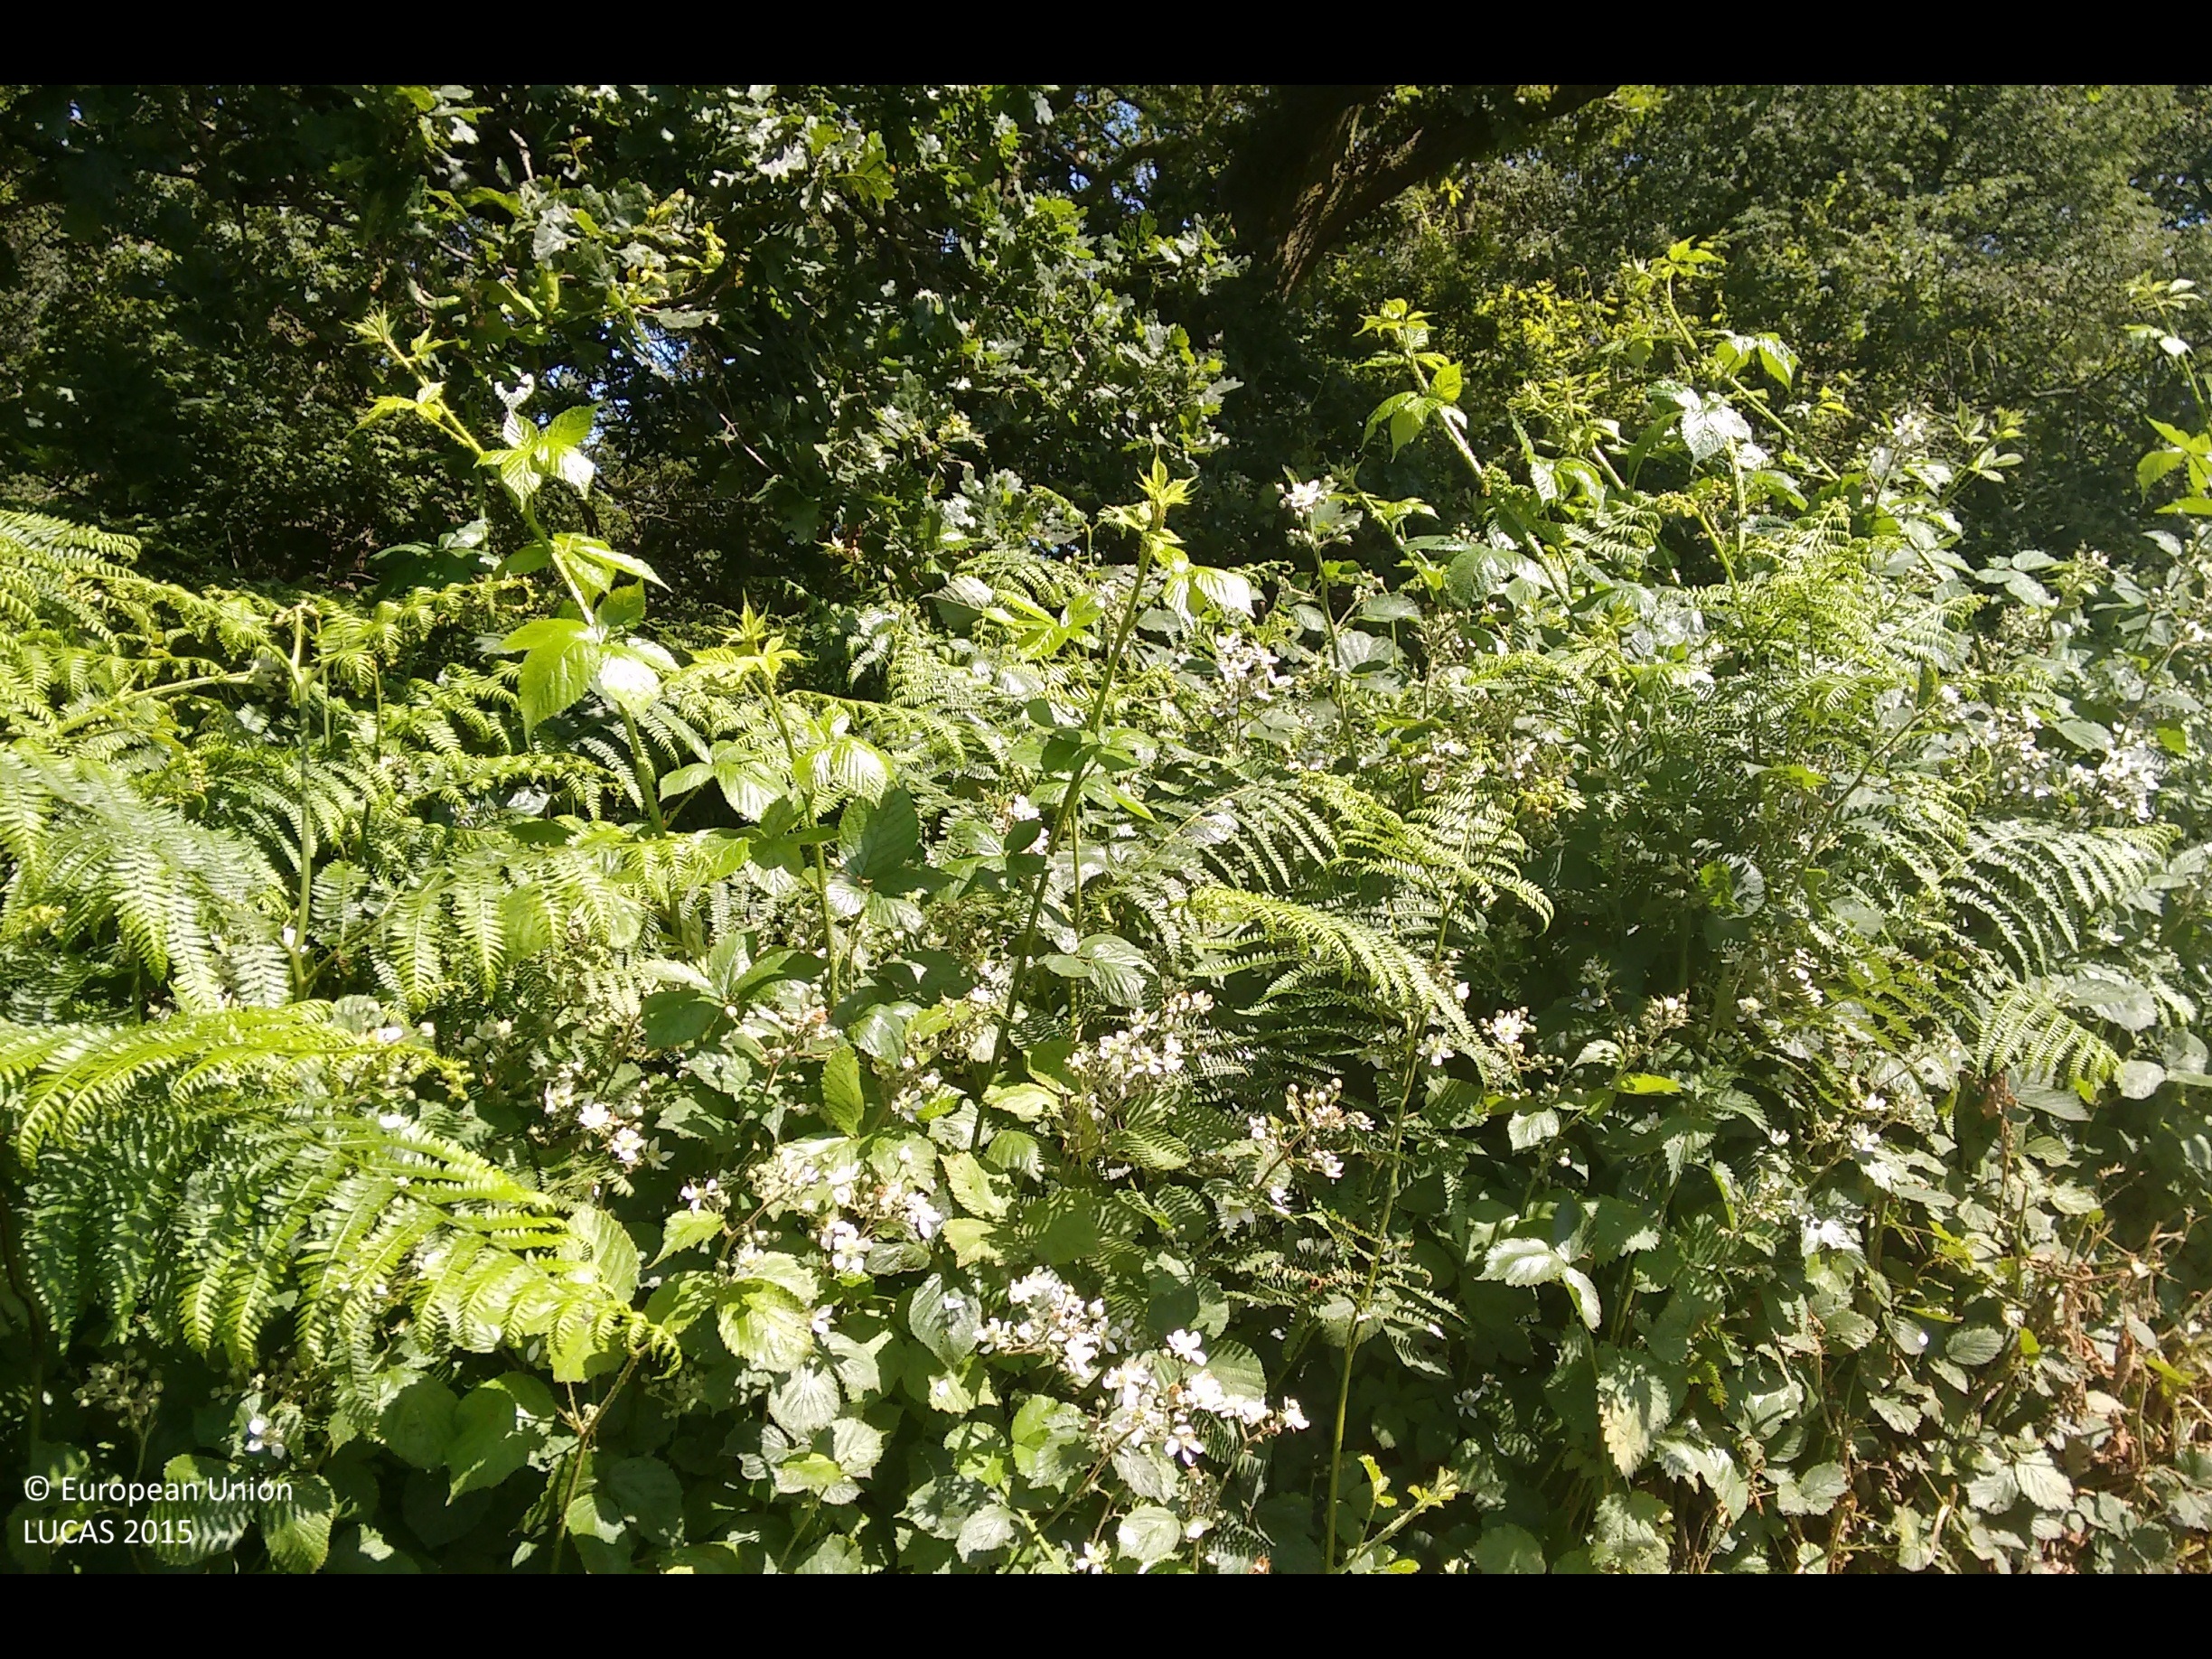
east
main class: Woodland
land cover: Broadleaved woodland
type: mesophytic deciduous forest
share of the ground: > 75 %
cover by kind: broadleaved forest trees 100 %
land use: Residential
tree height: > 5 m
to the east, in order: Broadleaved woodland; Fences; Broadleaved woodland; Grassland without tree/shrub cover; Broadleaved woodland; Fences; Artificial constructions in urban areas; Fences; Arable land (only in case pi)
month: July
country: GB
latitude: 53.3528
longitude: -2.4899
